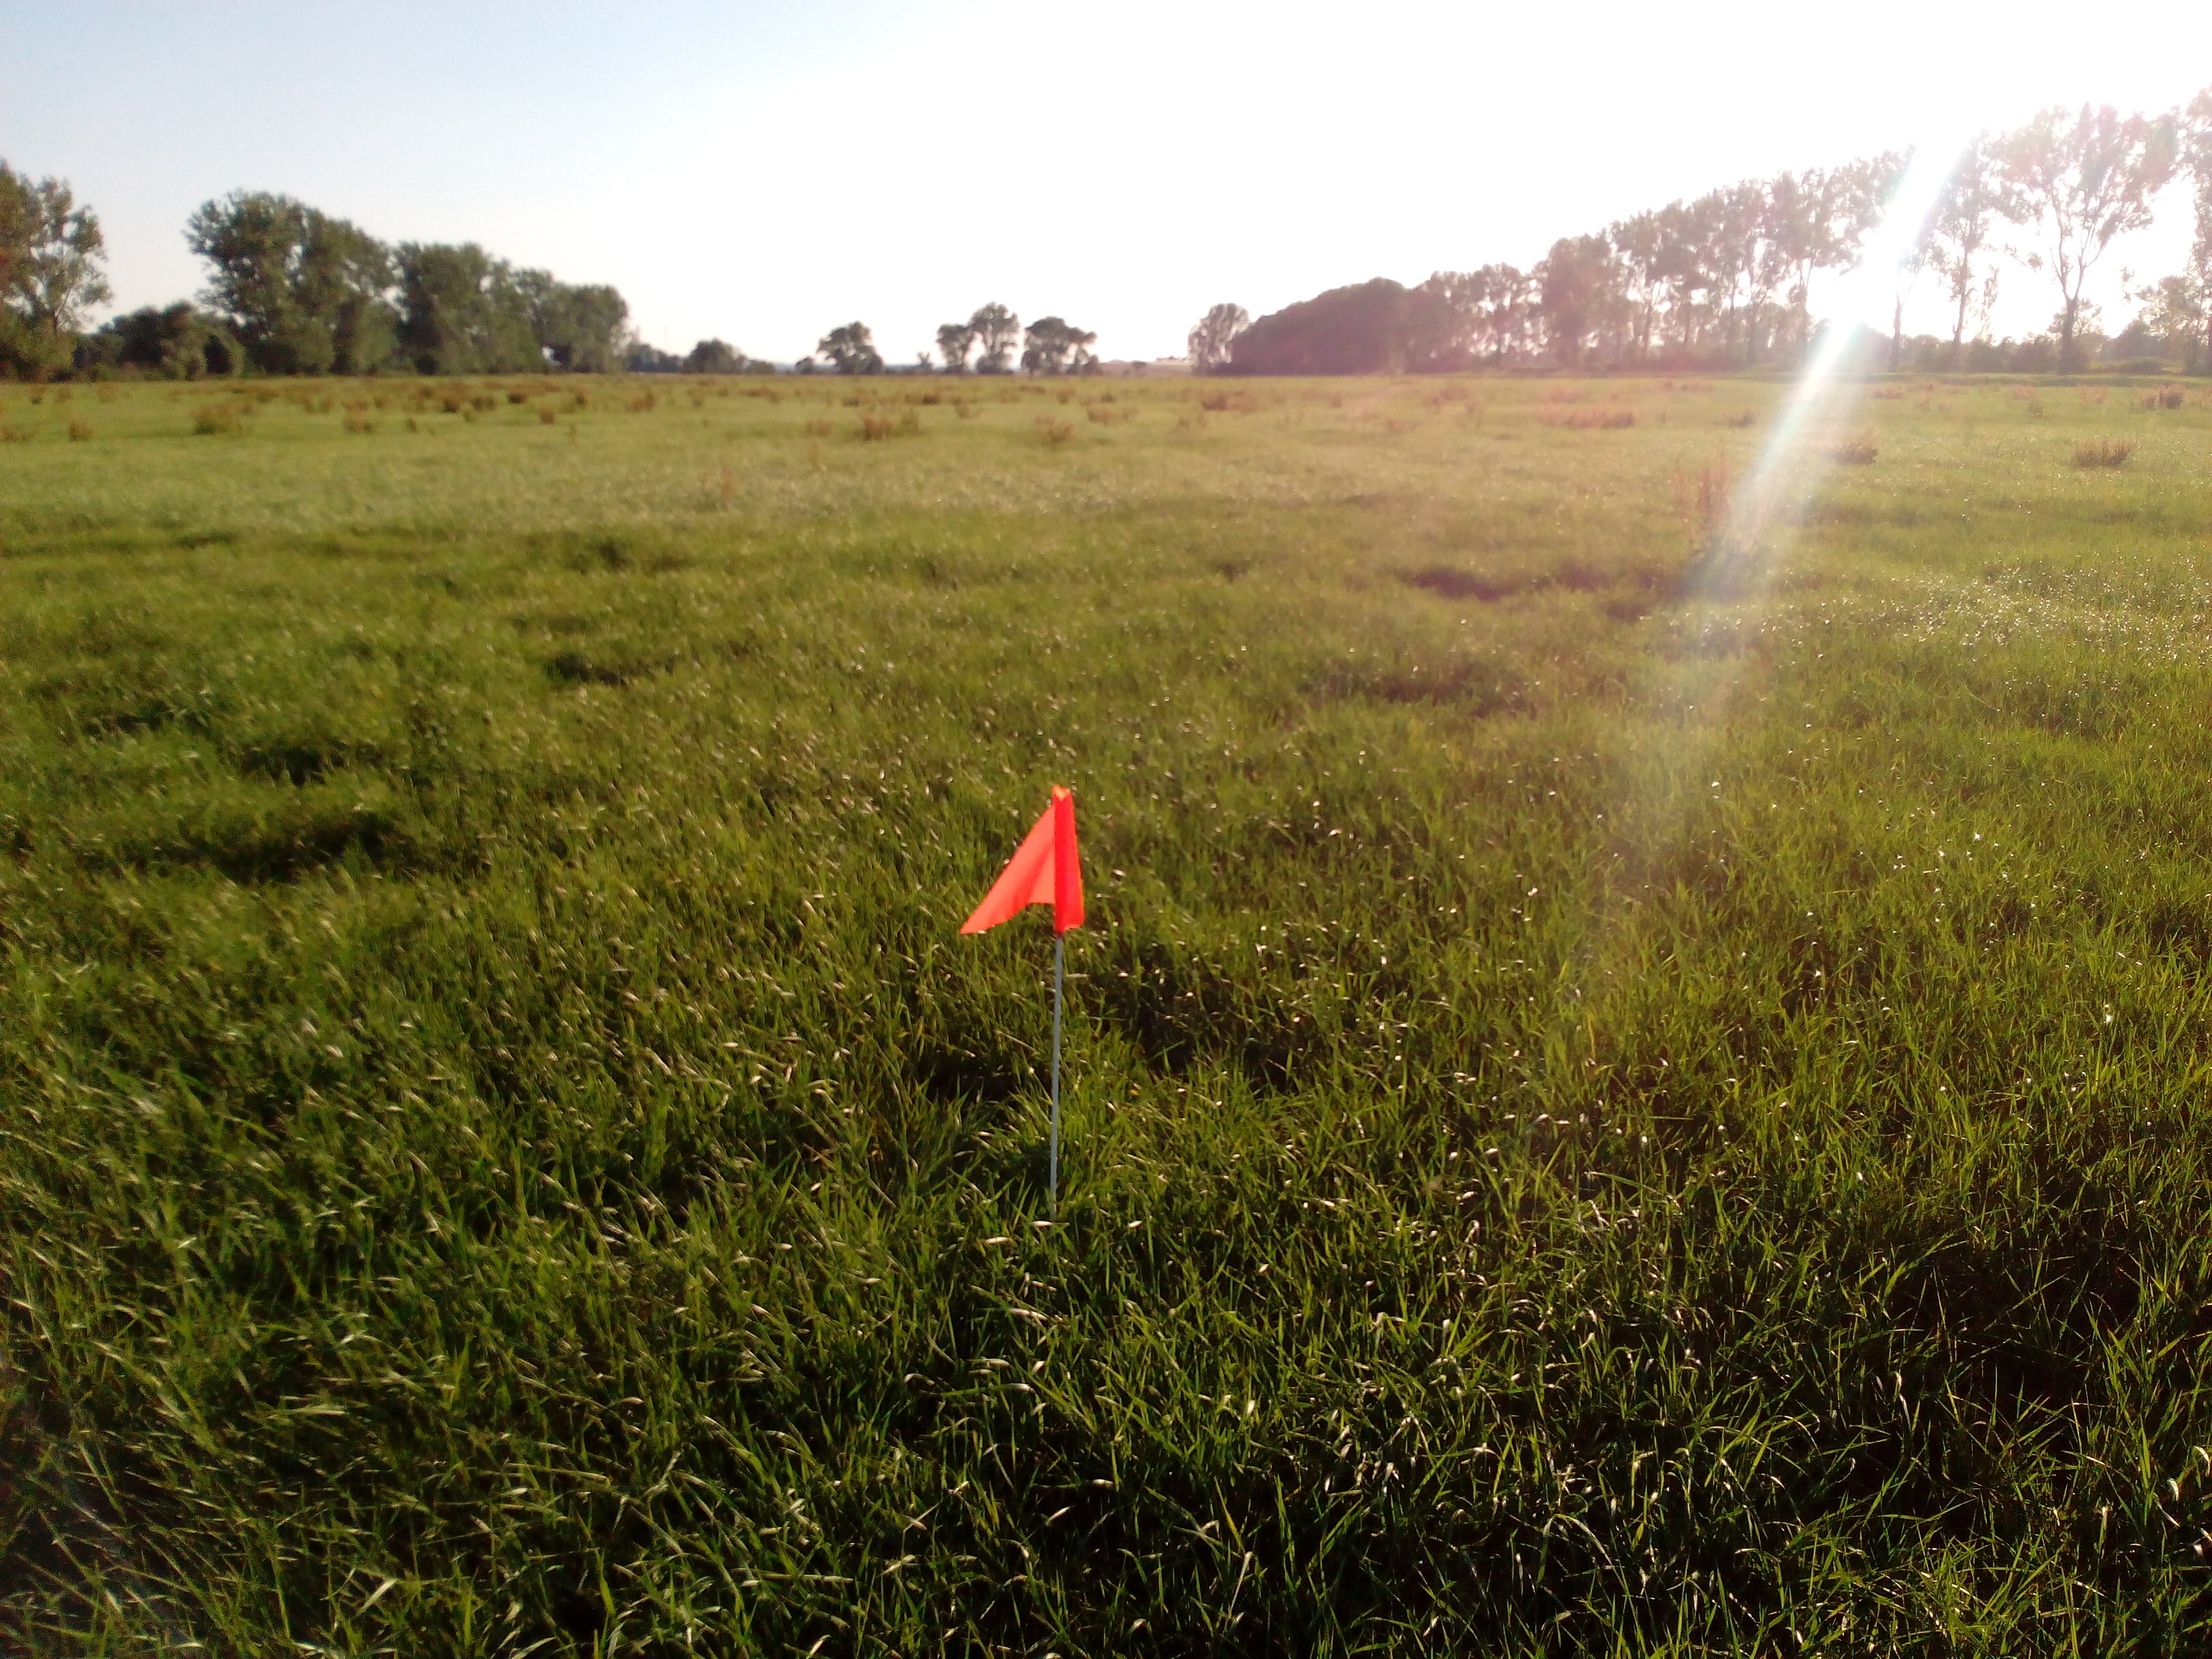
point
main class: Grassland
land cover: Grassland without tree/shrub cover
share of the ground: > 75 %
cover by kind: herbaceous plants 100 %
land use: Agriculture (excluding fallow land and kitchen gardens)
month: July
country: DE
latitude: 51.1334
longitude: 10.9286
